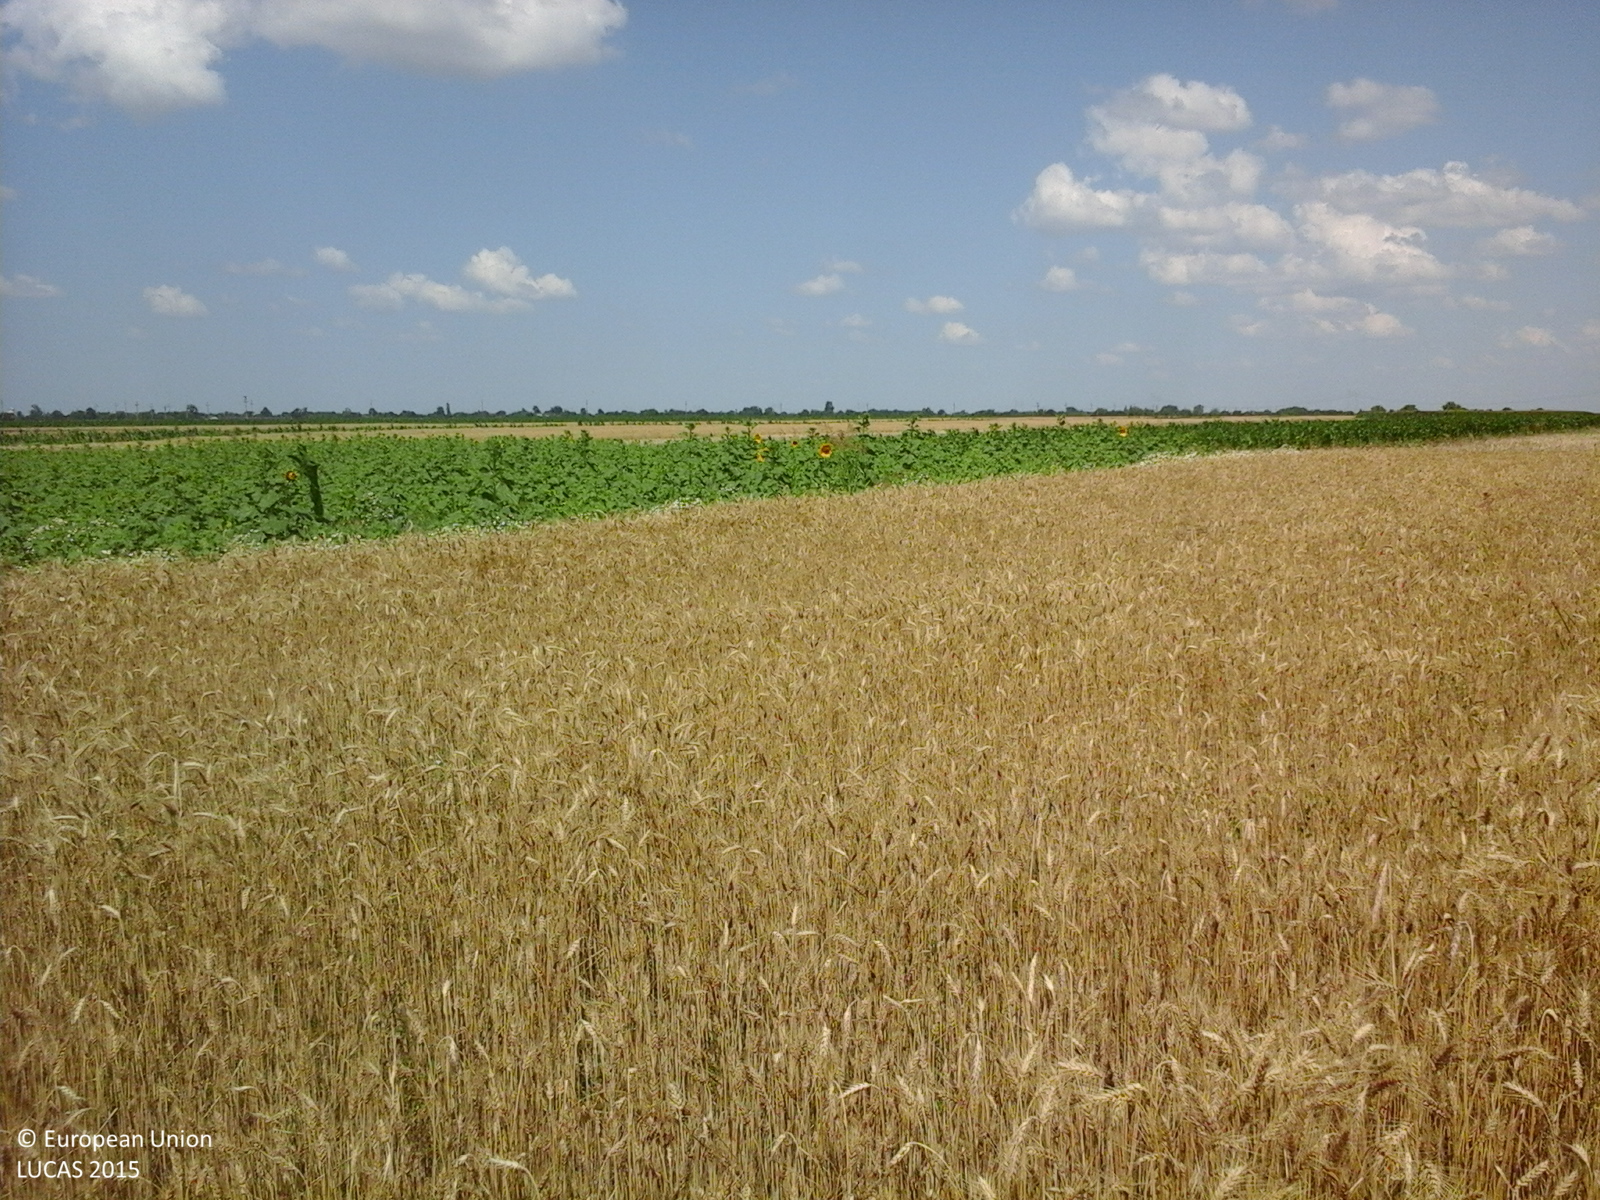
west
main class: Cropland
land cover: Common wheat
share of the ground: > 75 %
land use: Agriculture (excluding fallow land and kitchen gardens)
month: July
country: RO
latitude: 44.2415
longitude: 25.3756
